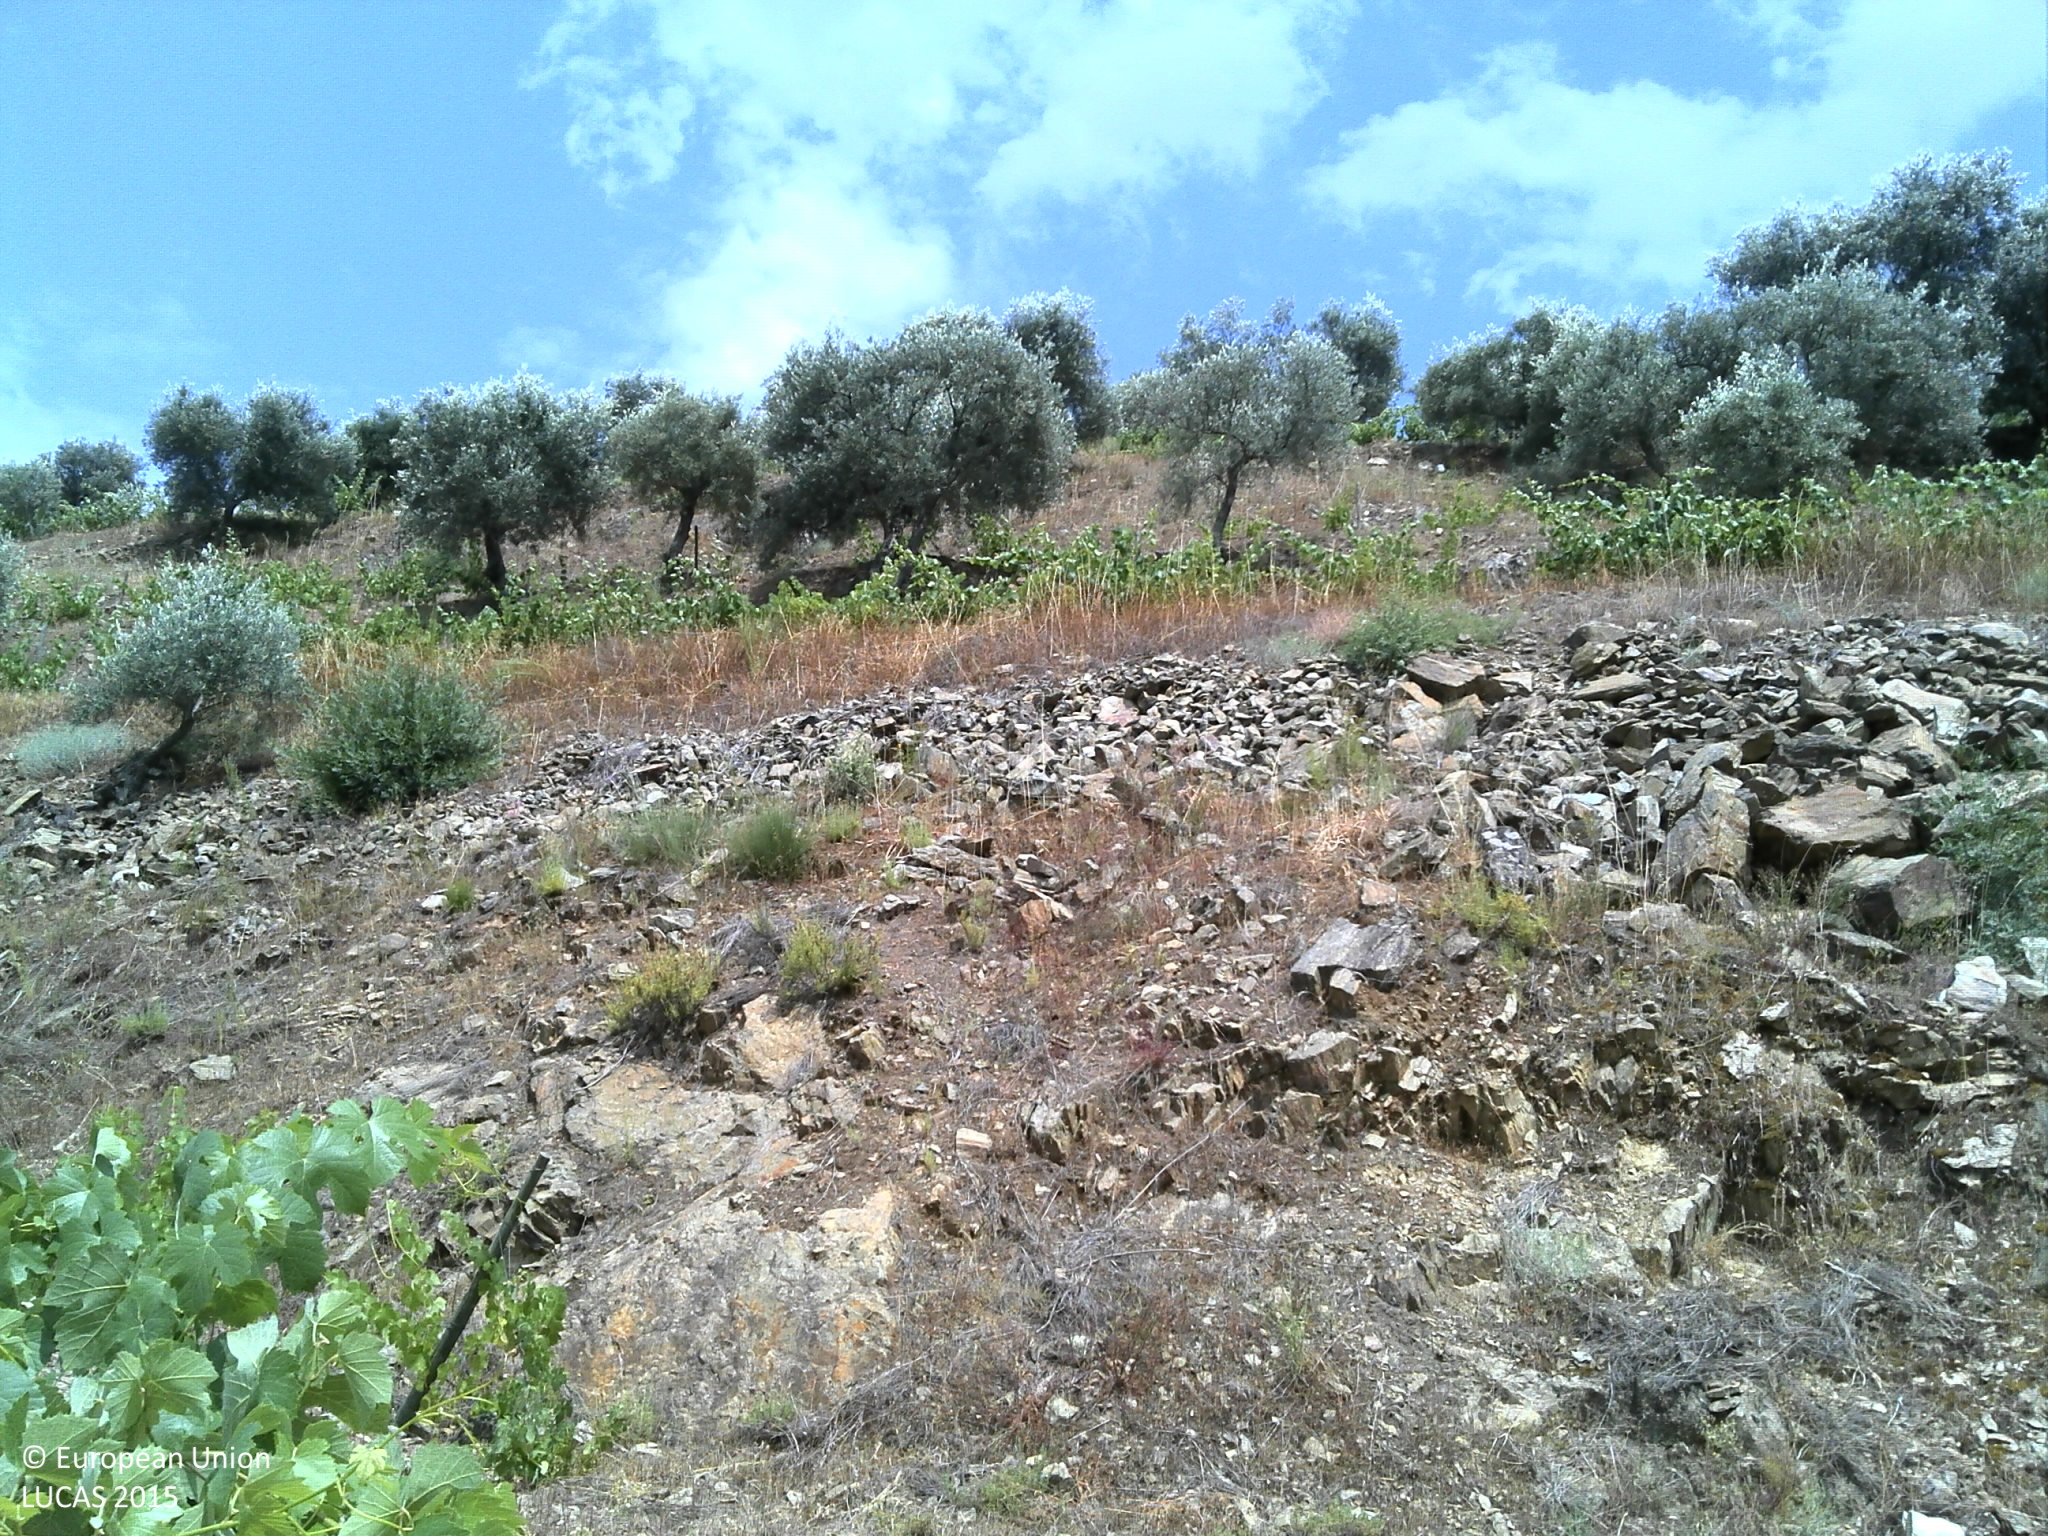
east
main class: Cropland
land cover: Olive groves
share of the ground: < 10 %
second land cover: Shrubland without tree cover
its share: 50 - 75 %
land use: Abandoned areas
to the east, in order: Olive groves; Shrubland without tree cover; Vineyards; Electric lines; Vineyards; Tracks; Vineyards; Olive groves; Vineyards; Olive groves; Vineyards; Olive groves; Vineyards; Olive groves; Vineyards; Olive groves; Vineyards; Olive groves; Vineyards; Olive groves; Vineyards; Tracks; Abandoned hedges; Olive groves; Vineyards
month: June
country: PT
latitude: 41.1386
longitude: -7.4789
